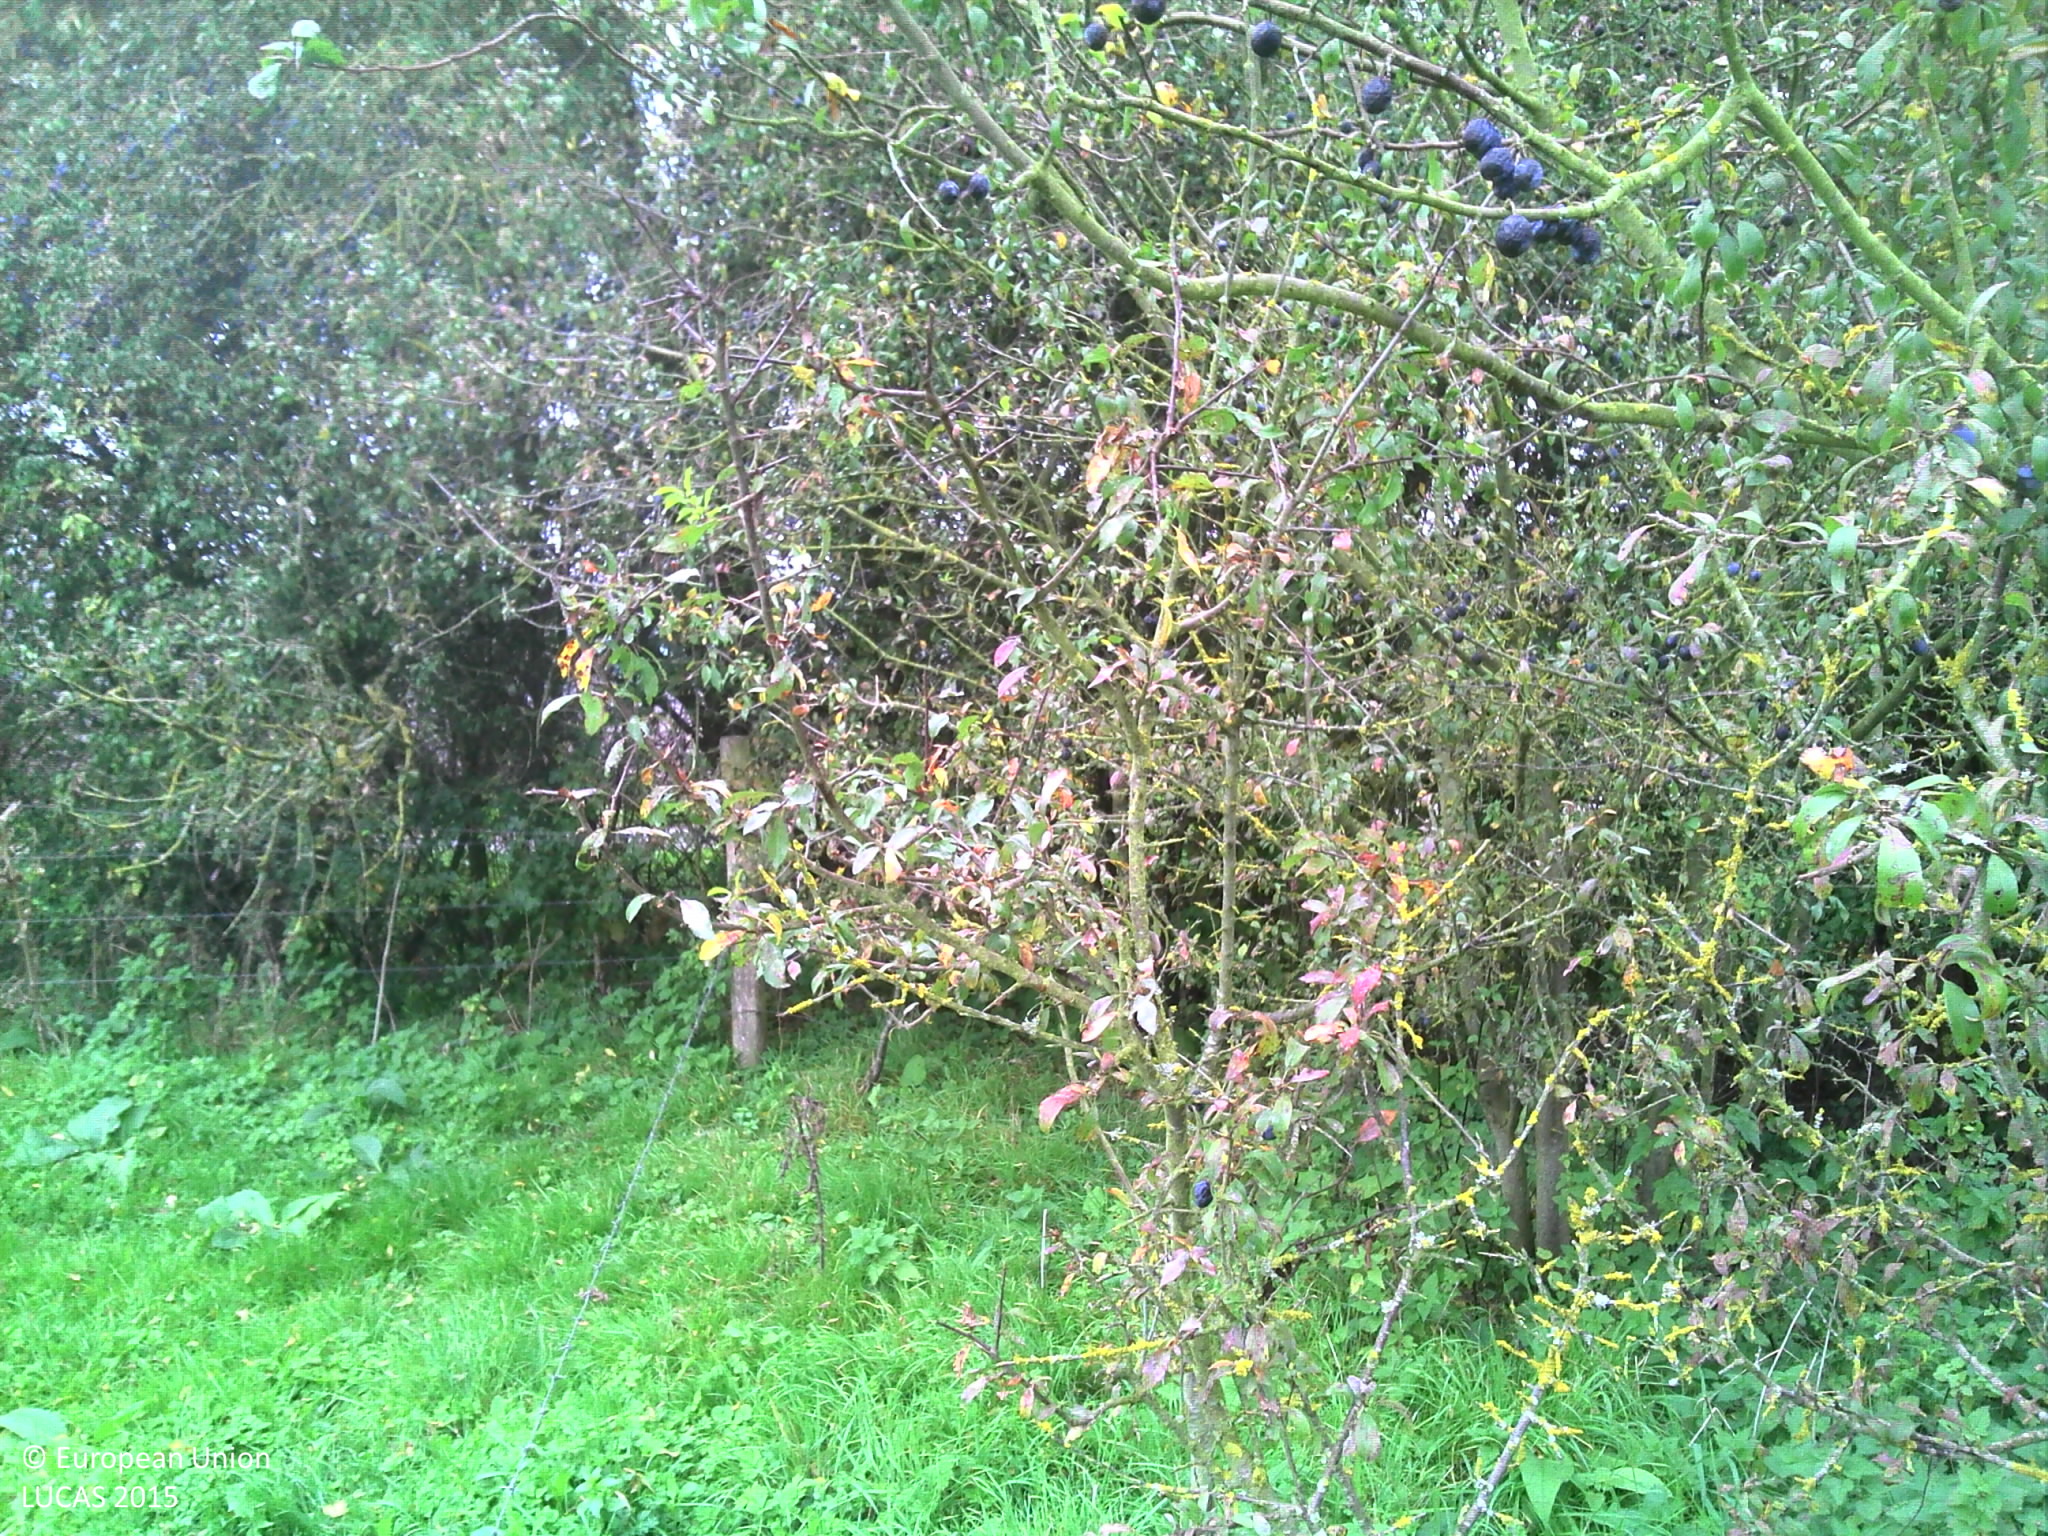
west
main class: Grassland
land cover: Grassland without tree/shrub cover
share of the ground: > 75 %
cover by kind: herbaceous plants 100 %
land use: Agriculture (excluding fallow land and kitchen gardens)
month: October
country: FR
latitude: 50.4203
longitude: 3.6170
